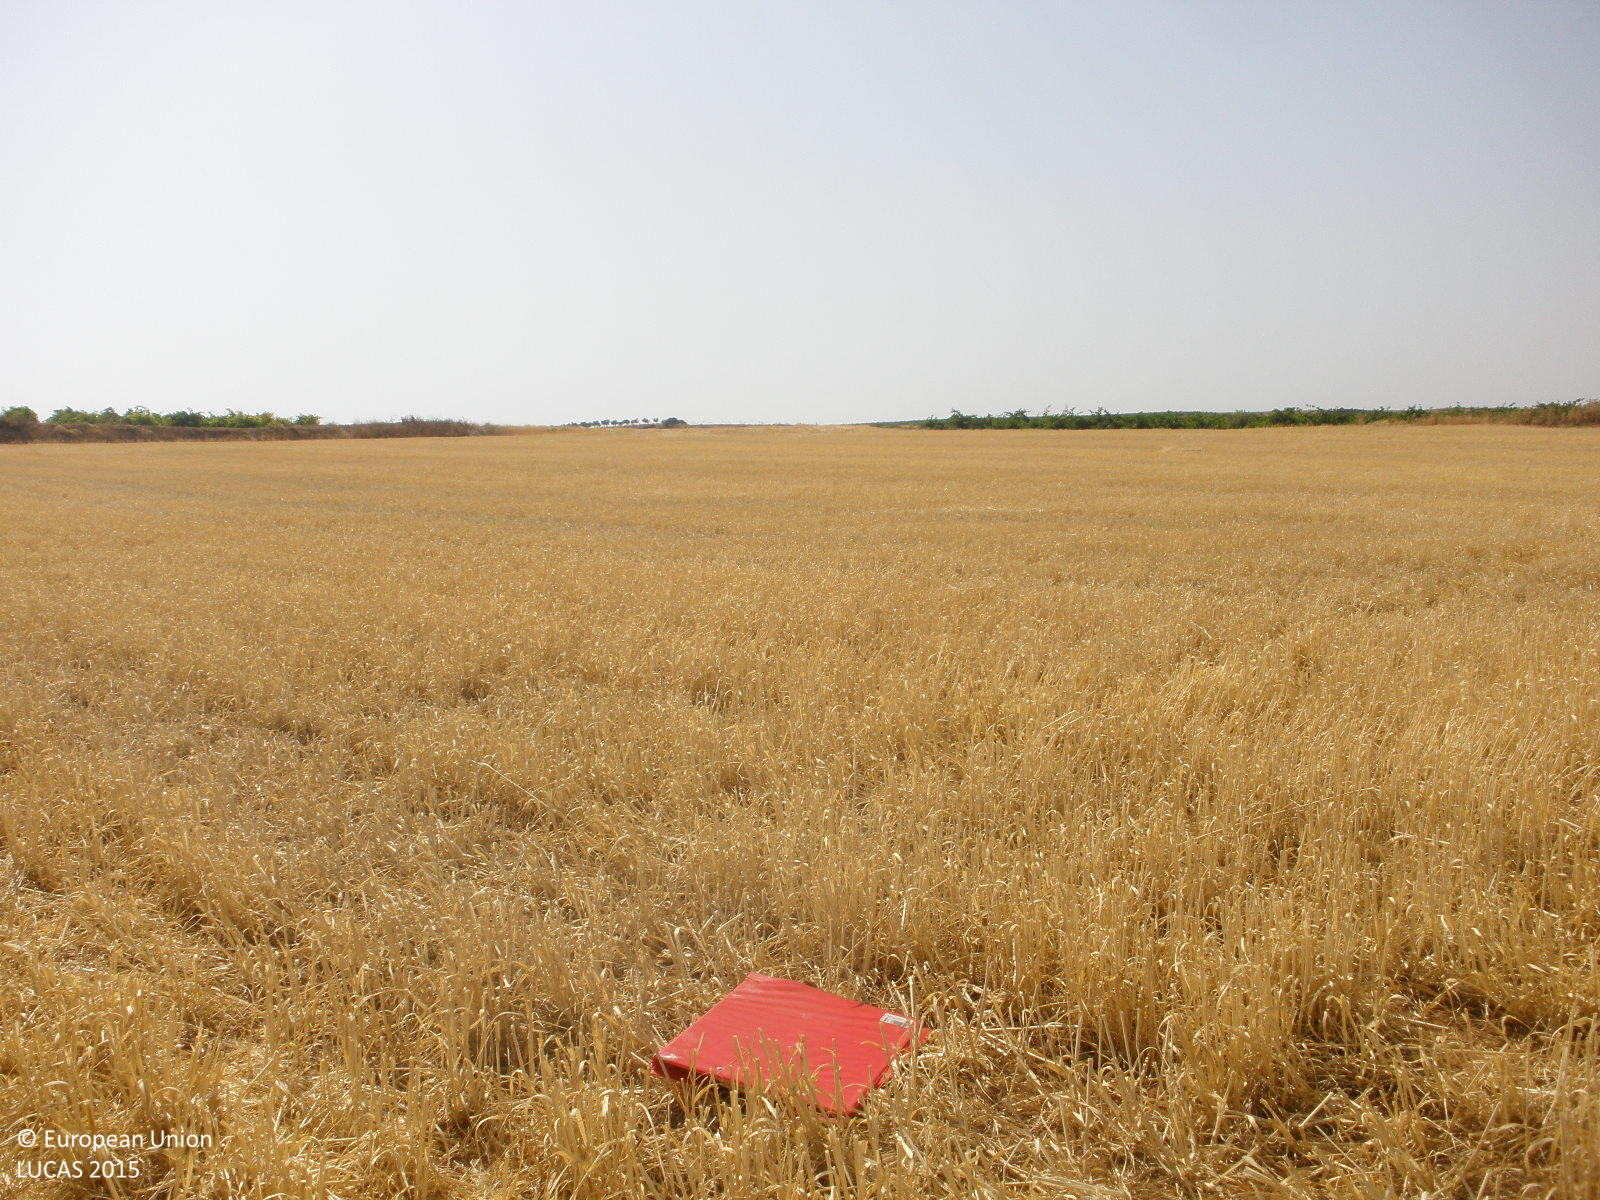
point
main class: Cropland
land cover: Barley
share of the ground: < 10 %
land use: Agriculture (excluding fallow land and kitchen gardens)
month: July
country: ES
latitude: 39.7503
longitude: -3.1046
